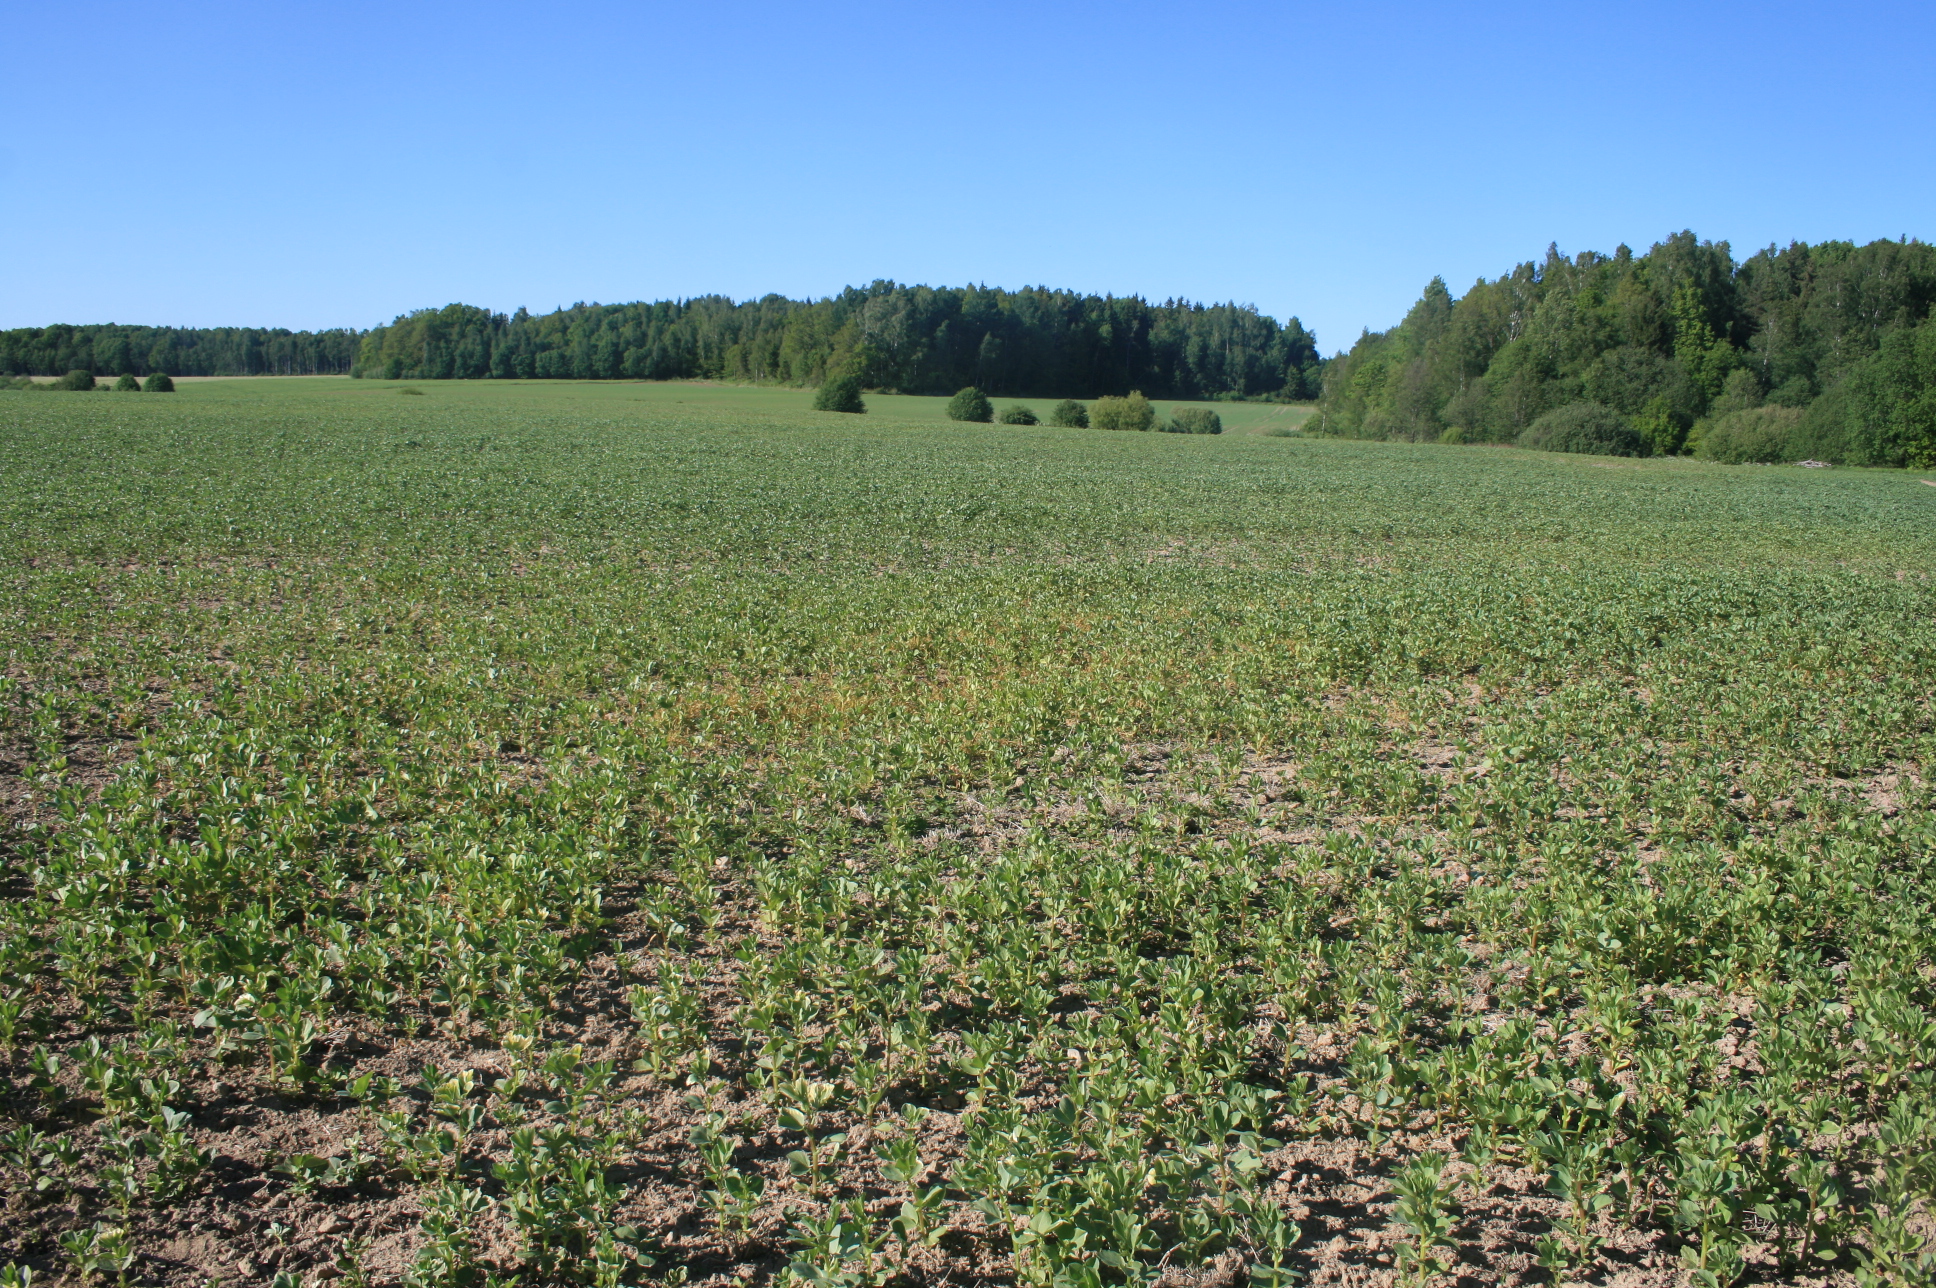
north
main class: Cropland
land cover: Dry pulses
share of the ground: 50 - 75 %
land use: Agriculture (excluding fallow land and kitchen gardens)
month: June
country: LT
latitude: 55.9508
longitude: 21.3971
